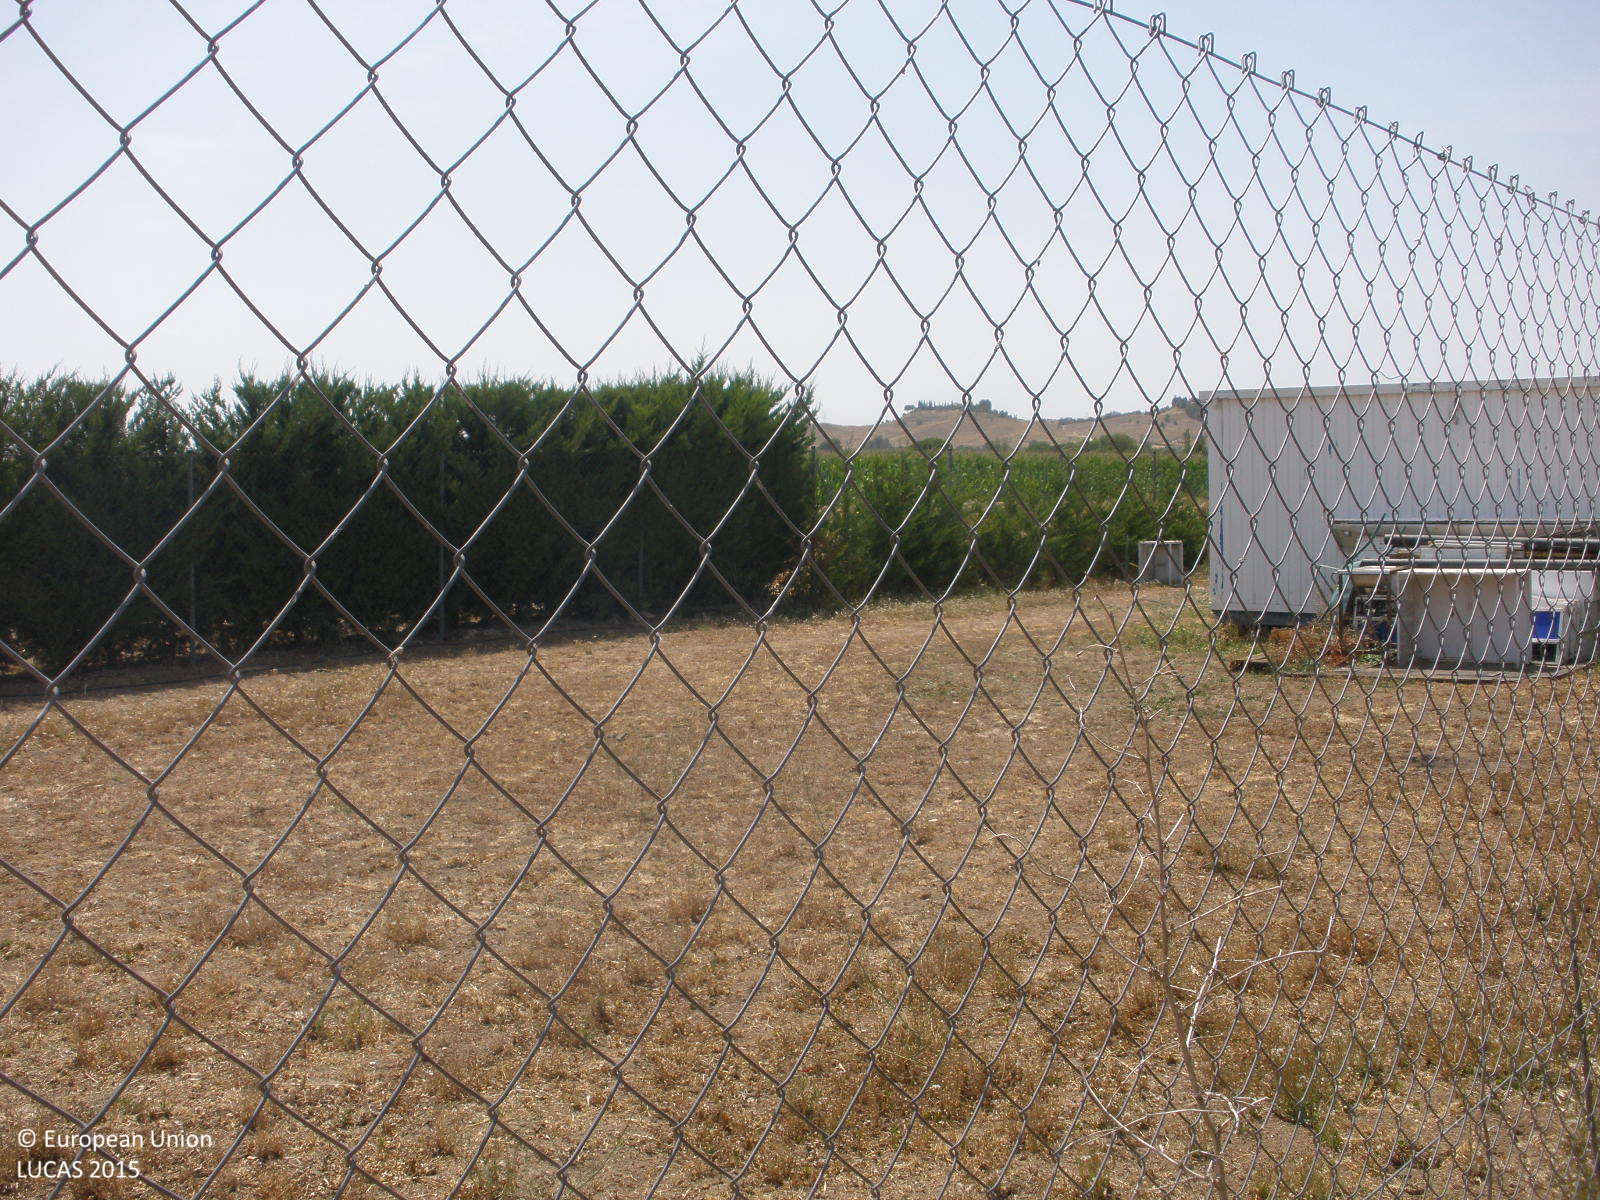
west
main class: Cropland
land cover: Maize
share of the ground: > 75 %
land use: Agriculture (excluding fallow land and kitchen gardens)
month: July
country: ES
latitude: 40.1961
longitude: -3.4582
